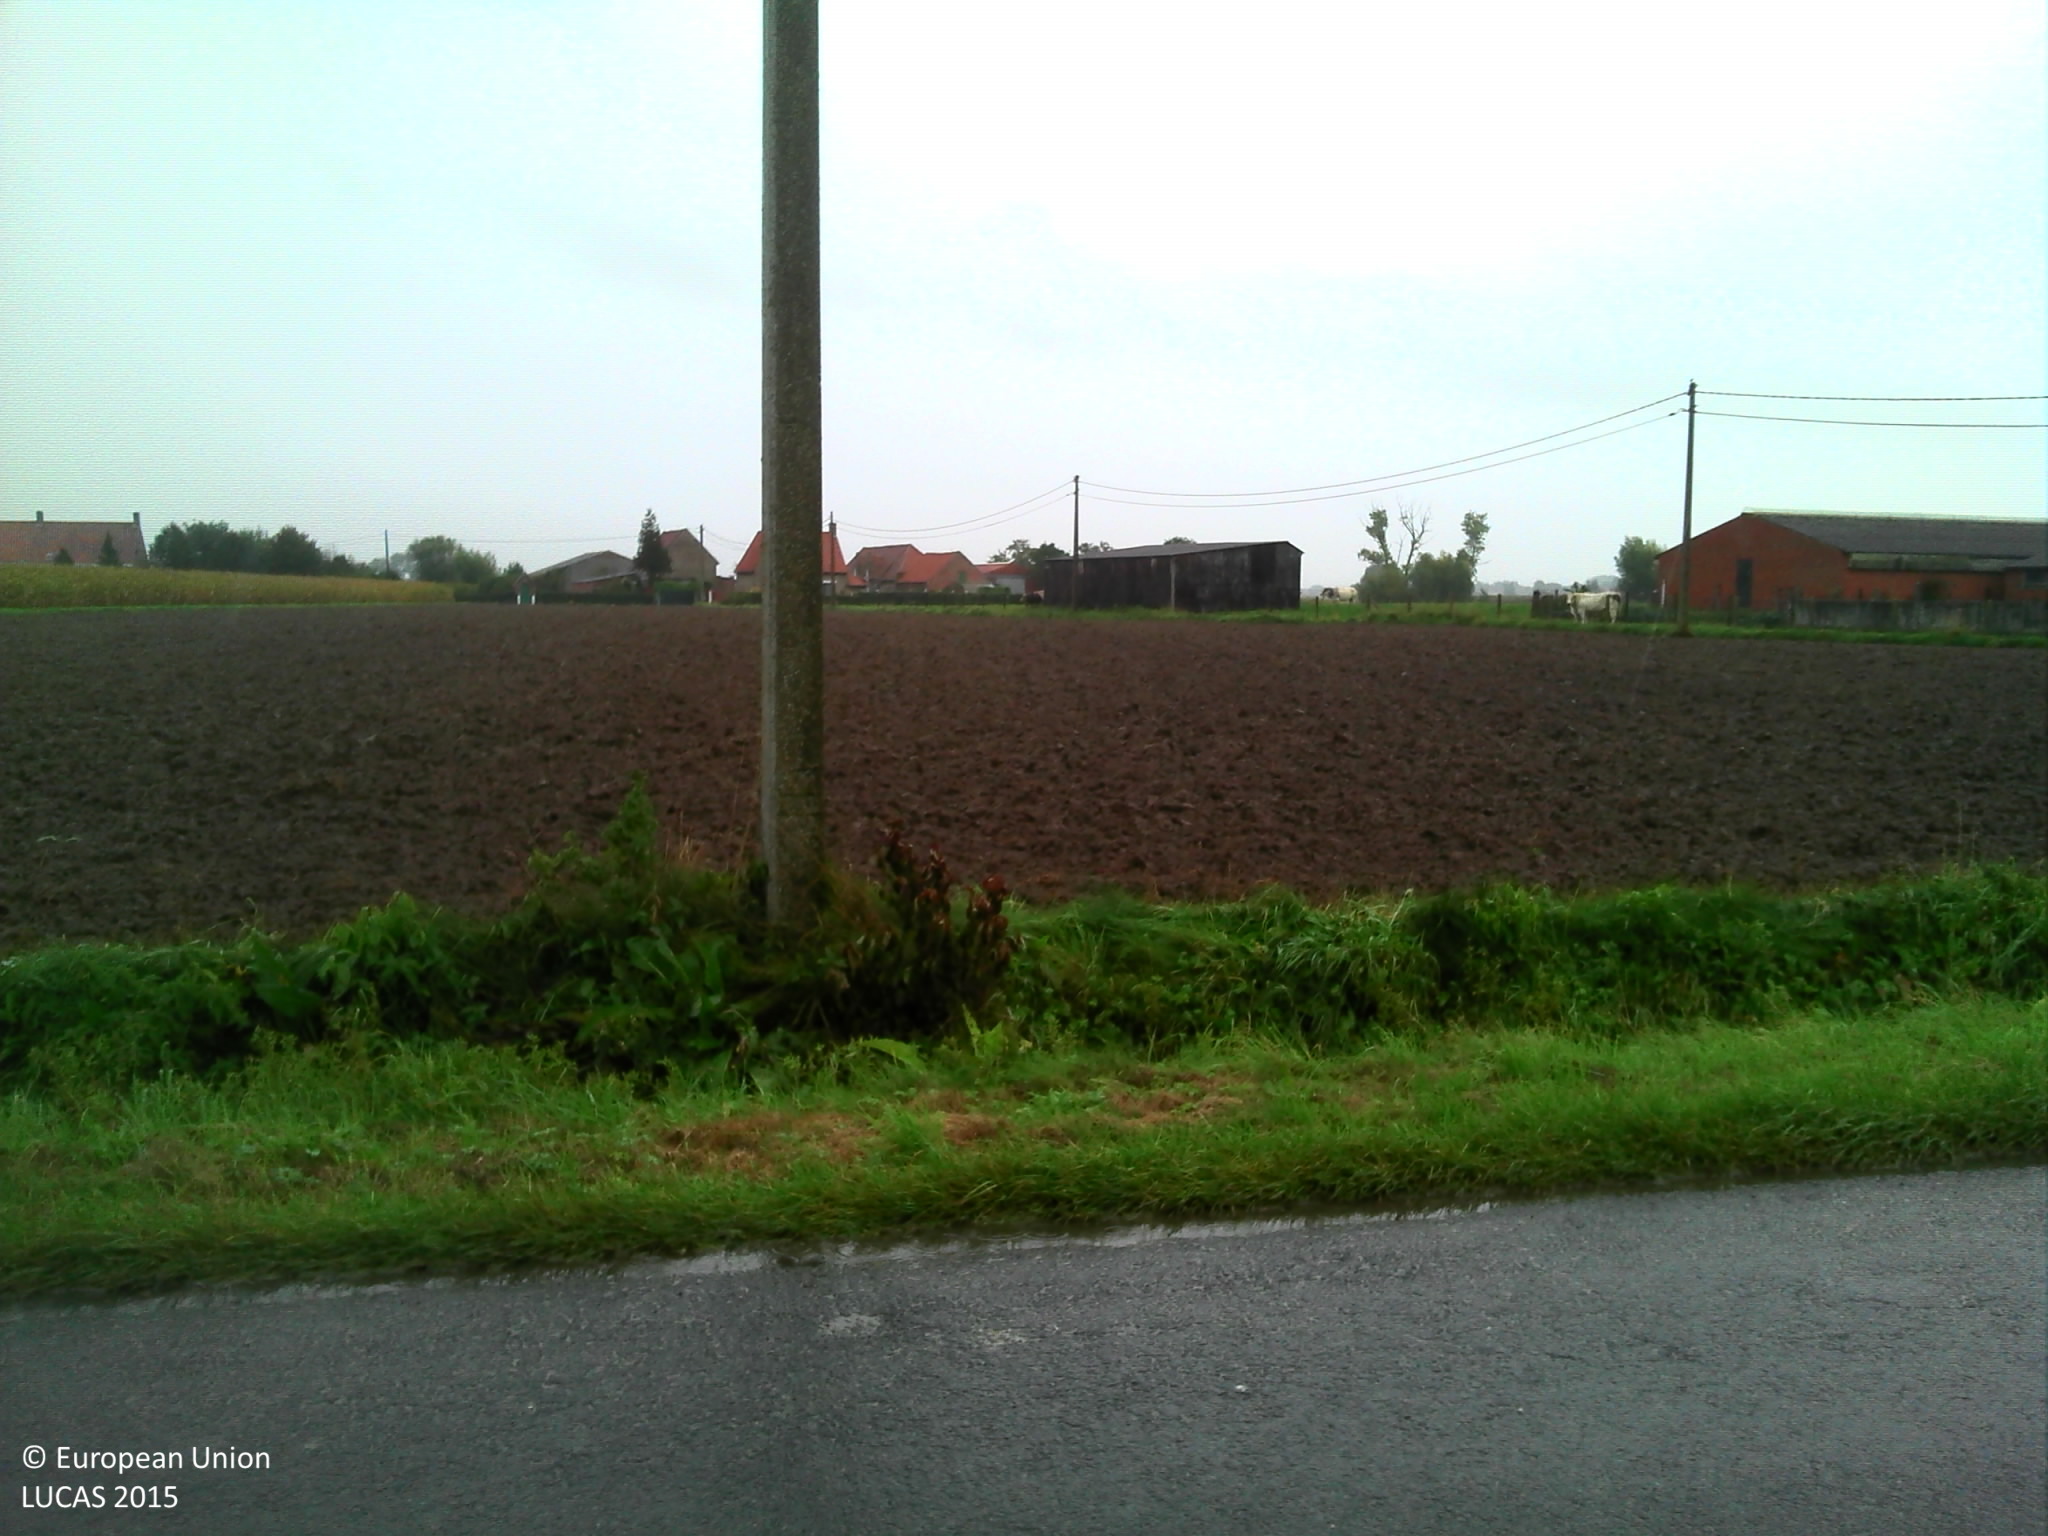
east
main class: Cropland
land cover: Maize
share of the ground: > 75 %
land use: Agriculture (excluding fallow land and kitchen gardens)
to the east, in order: Maize; Grass margins; Ditches and canals; Grass margins; Paved roads, cycling and walking lanes; Grass margins; Ditches and canals; Electric lines; Other bare soil; Electric lines; Other bare soil; Grass margins; Fences; Grassland without tree/shrub cover; Fences; Managed hedges; Ditches and canals; Fences; Grassland without tree/shrub cover
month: October
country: BE
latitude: 50.9207
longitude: 2.9195
